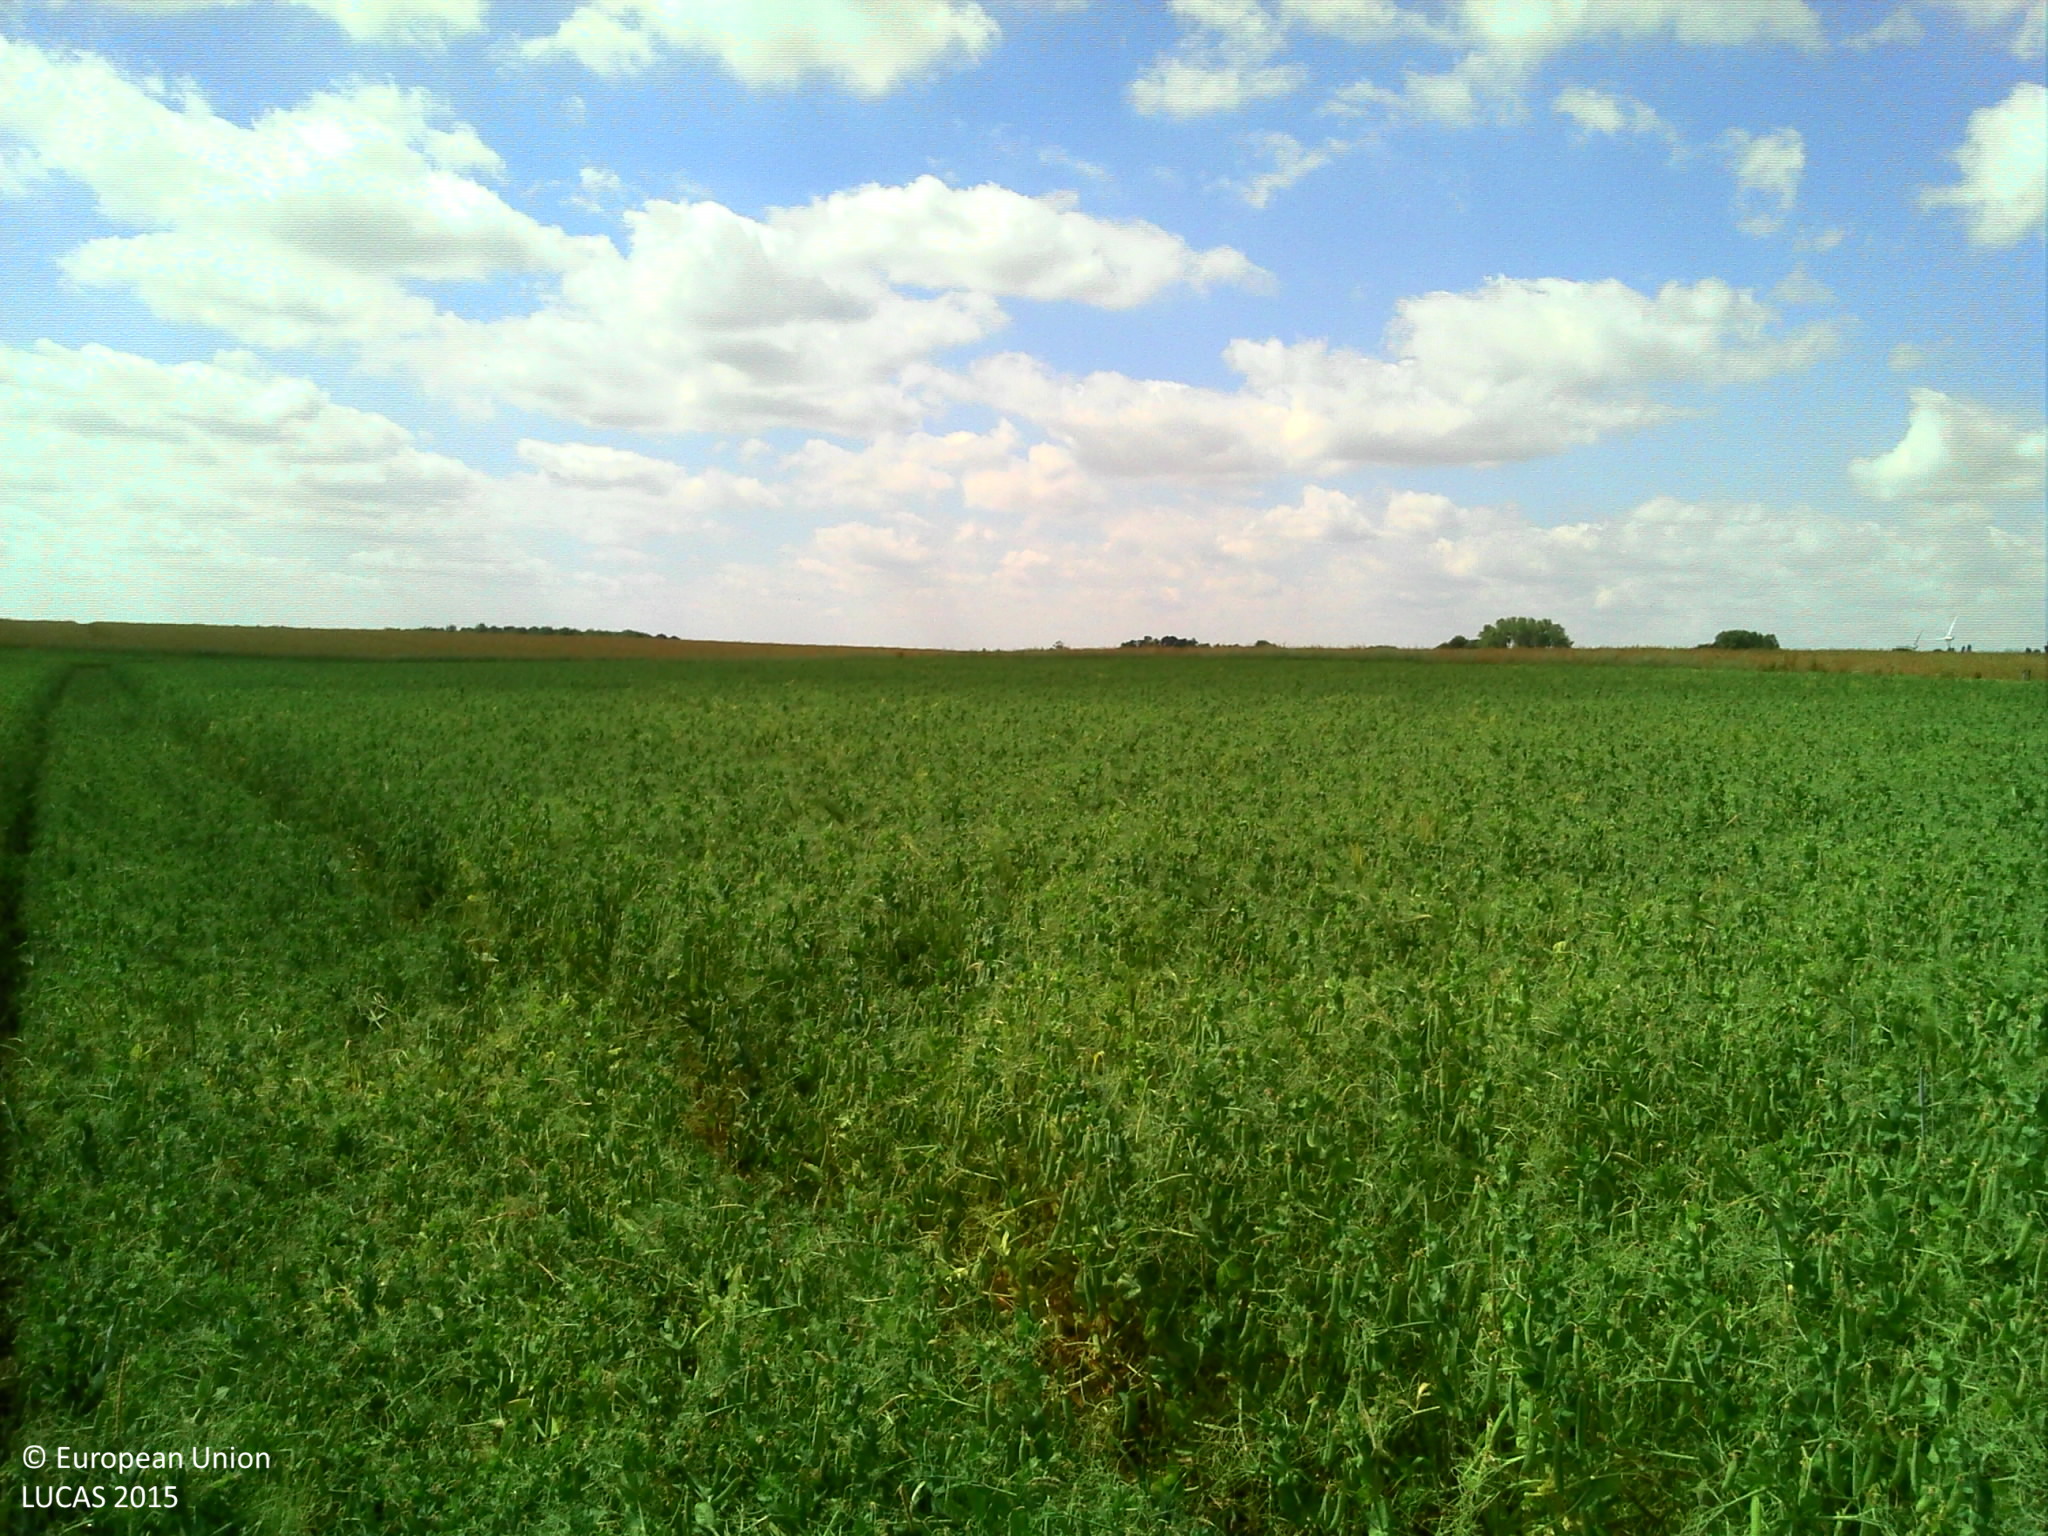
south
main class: Cropland
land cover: Dry pulses
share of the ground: > 75 %
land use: Agriculture (excluding fallow land and kitchen gardens)
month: July
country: FR
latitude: 49.6513
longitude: 1.7697
